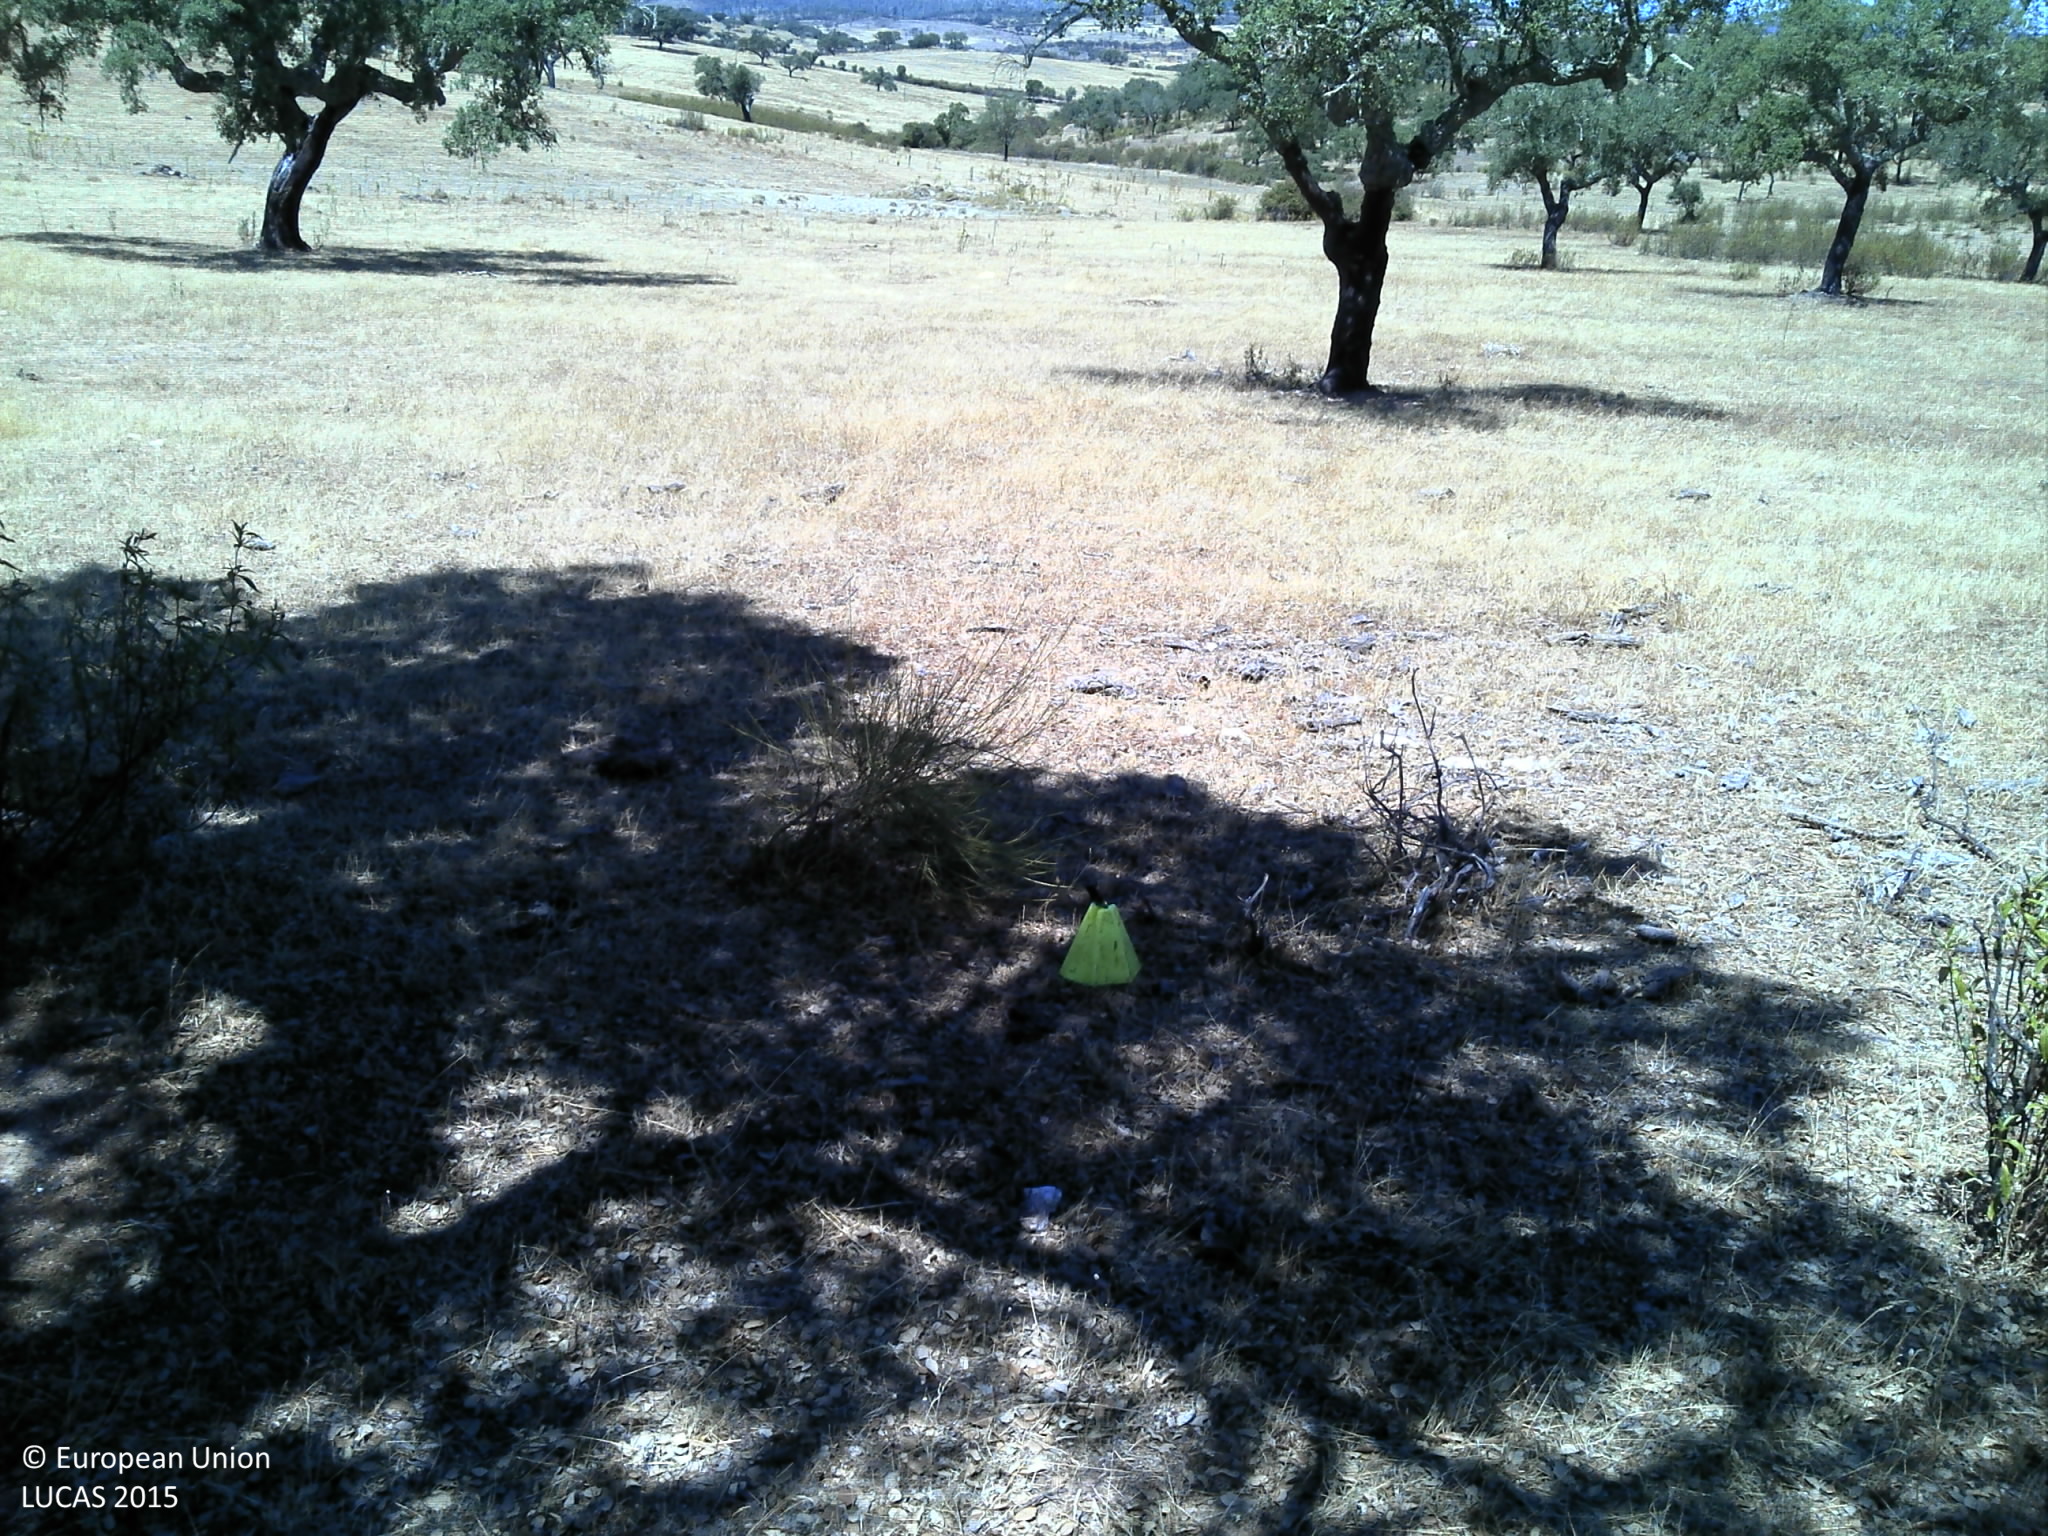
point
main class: Woodland
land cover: Broadleaved woodland
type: broadleaved evergreen forest
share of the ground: 10 - 25 %
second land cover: Grassland without tree/shrub cover
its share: 10 - 25 %
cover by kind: unconsolidated bare surface 80 %, broadleaved forest trees 10 %, herbaceous plants 10 %
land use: Forestry
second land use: Agriculture (excluding fallow land and kitchen gardens)
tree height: > 5 m
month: August
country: PT
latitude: 39.5549
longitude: -7.5647
